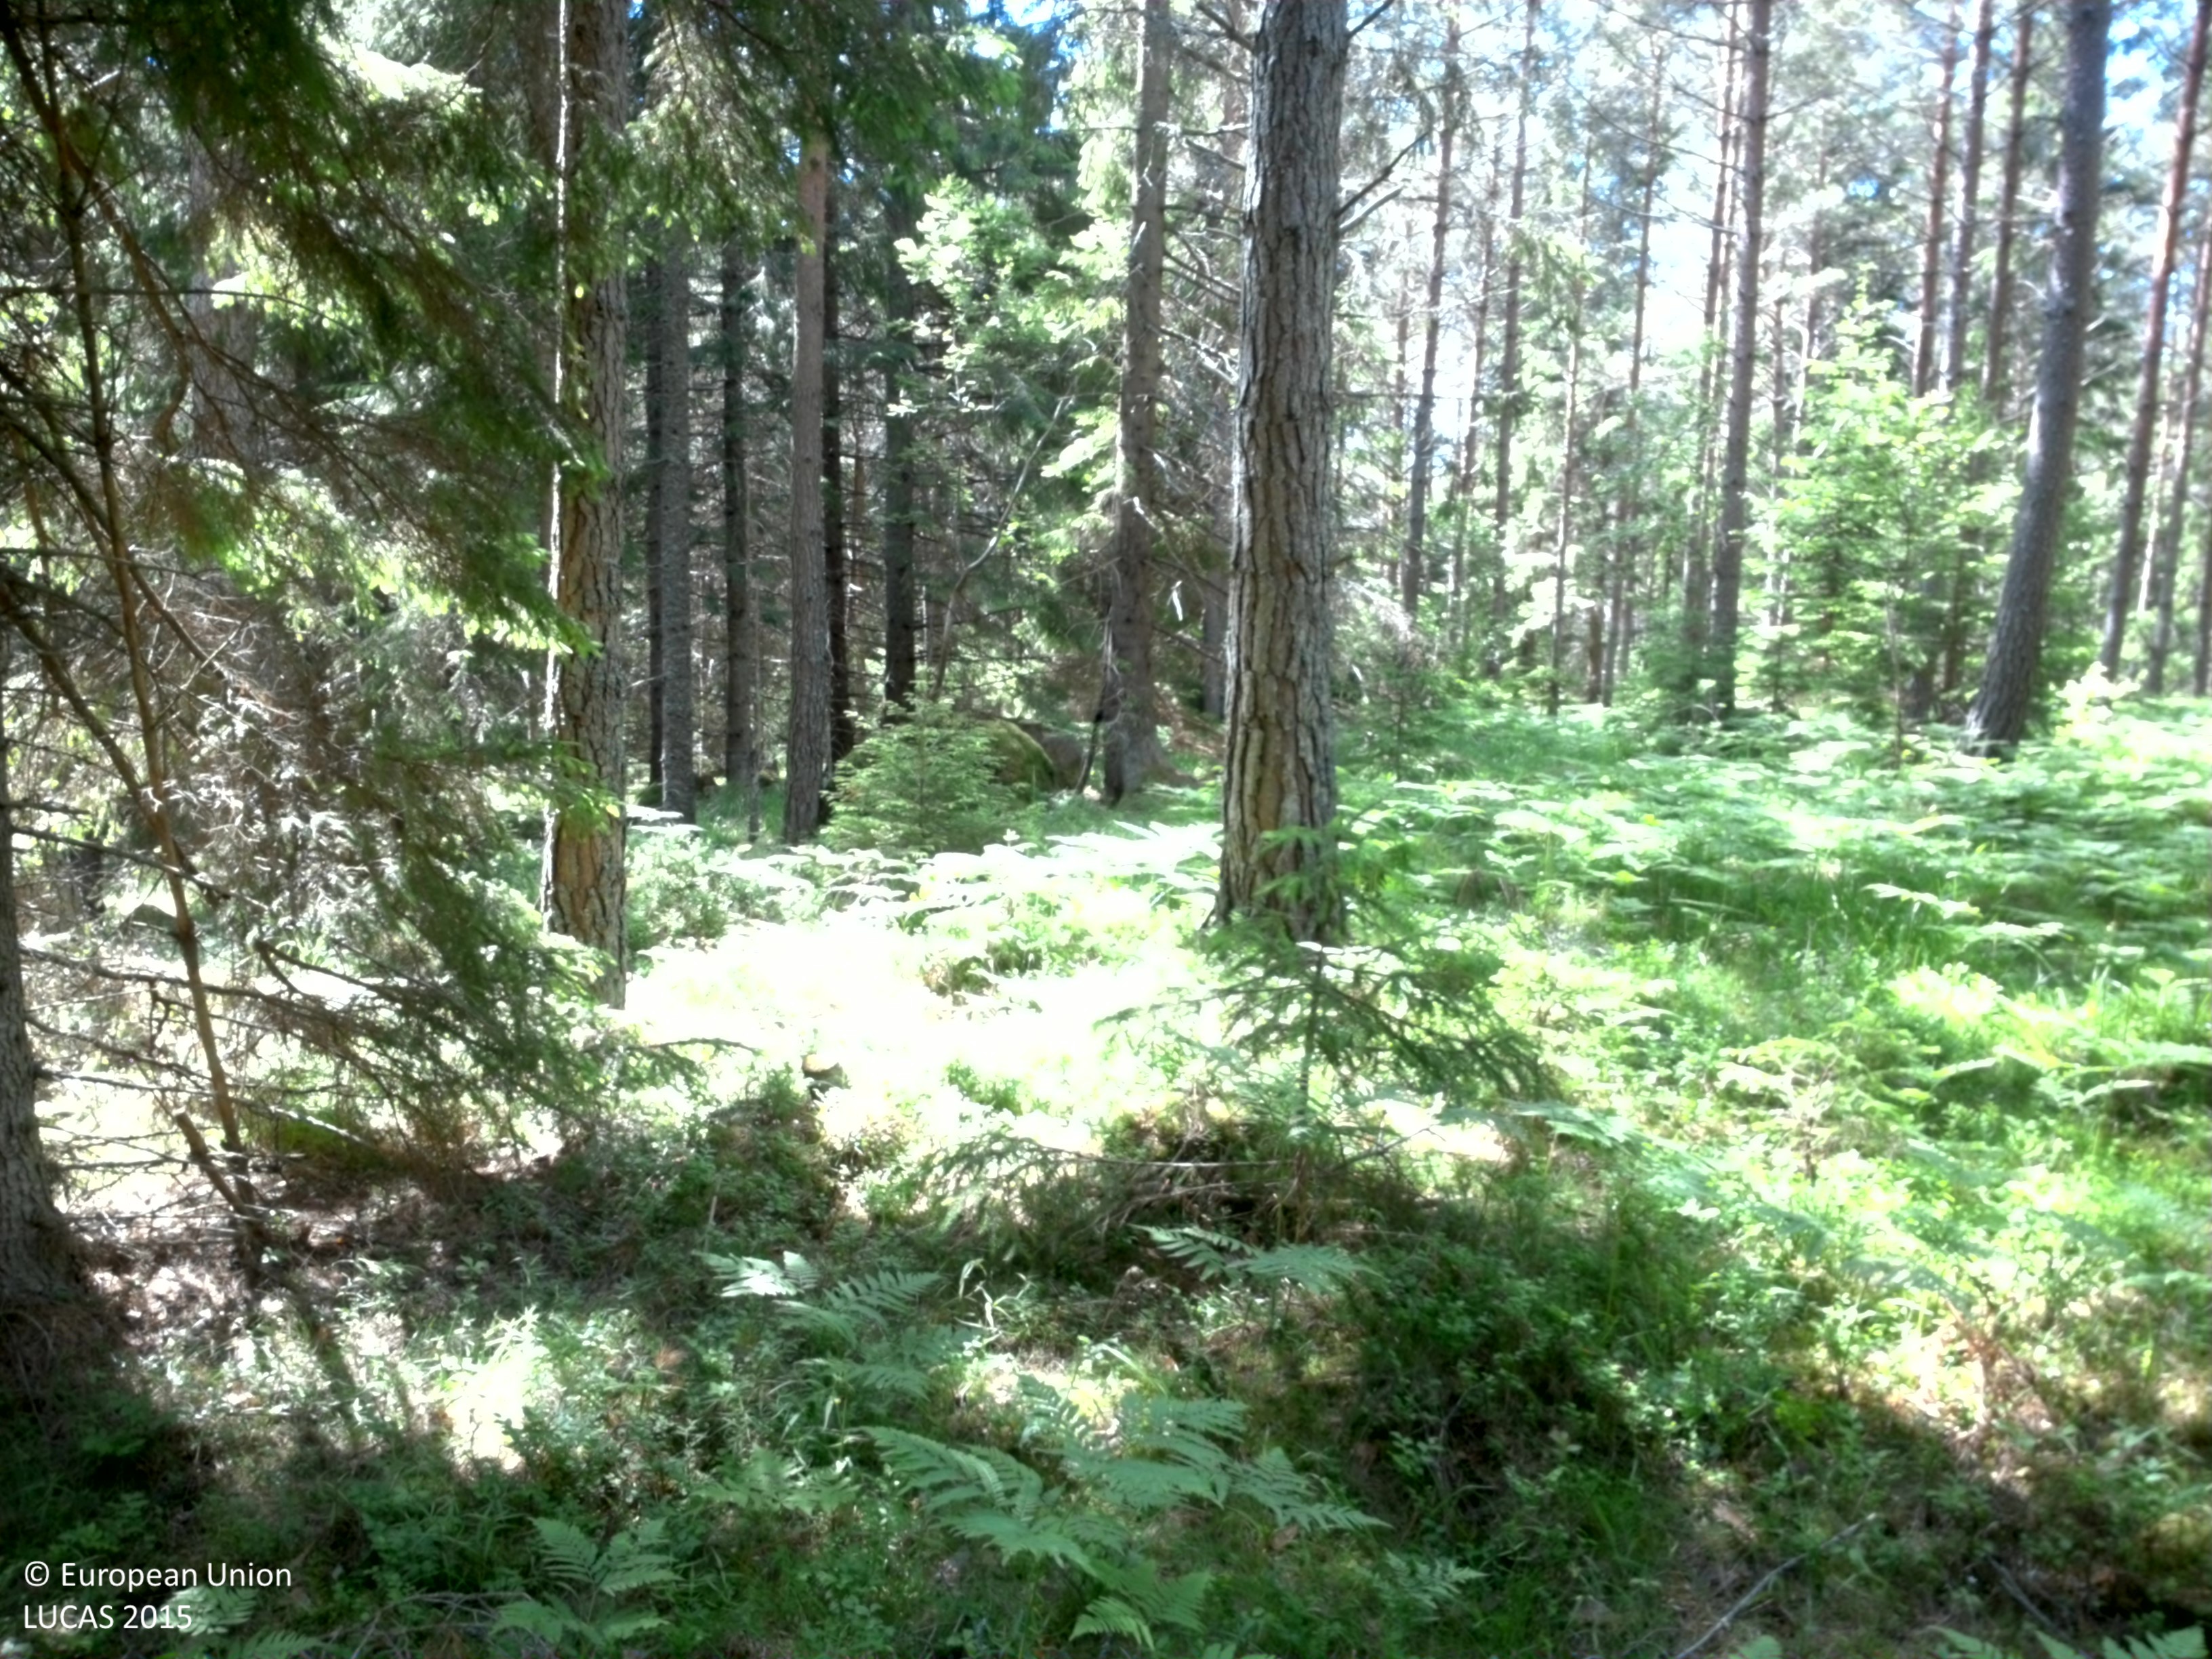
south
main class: Woodland
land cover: Pine dominated coniferous woodland
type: boreal forest
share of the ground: 10 - 25 %
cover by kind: herbaceous plants 60 %, coniferous forest trees 20 %, lichens and mosses 20 %
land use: Community services
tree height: > 5 m
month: June
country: SE
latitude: 58.5974
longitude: 15.4139
